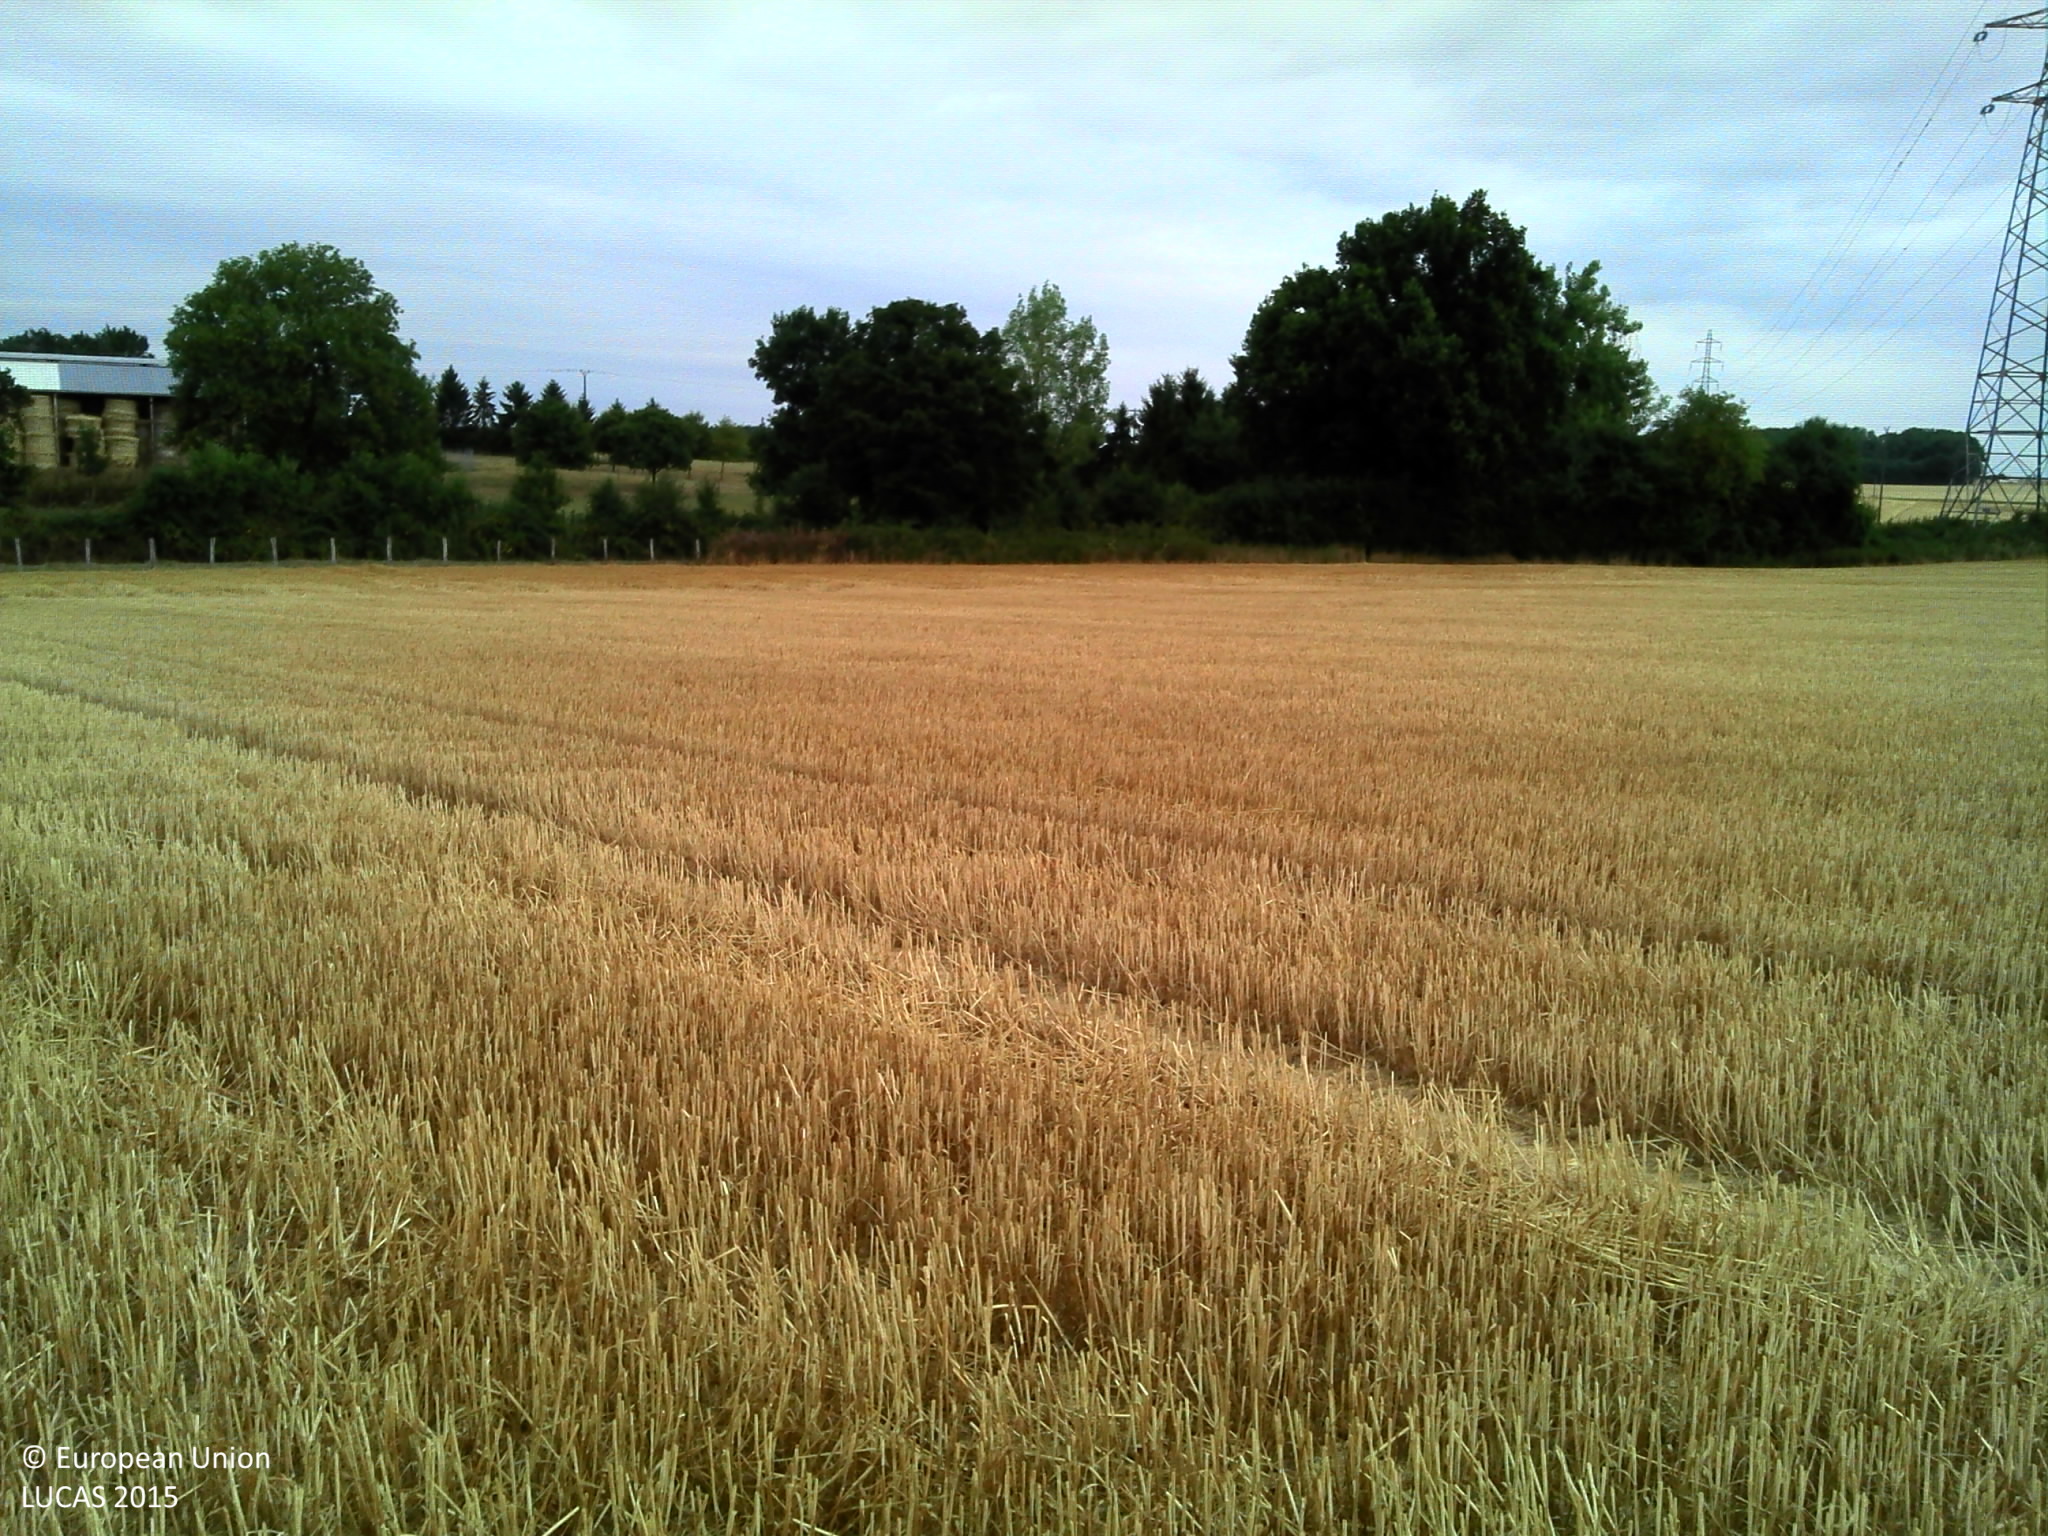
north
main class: Cropland
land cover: Common wheat
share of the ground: > 75 %
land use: Agriculture (excluding fallow land and kitchen gardens)
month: July
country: FR
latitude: 48.0262
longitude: 3.1144
